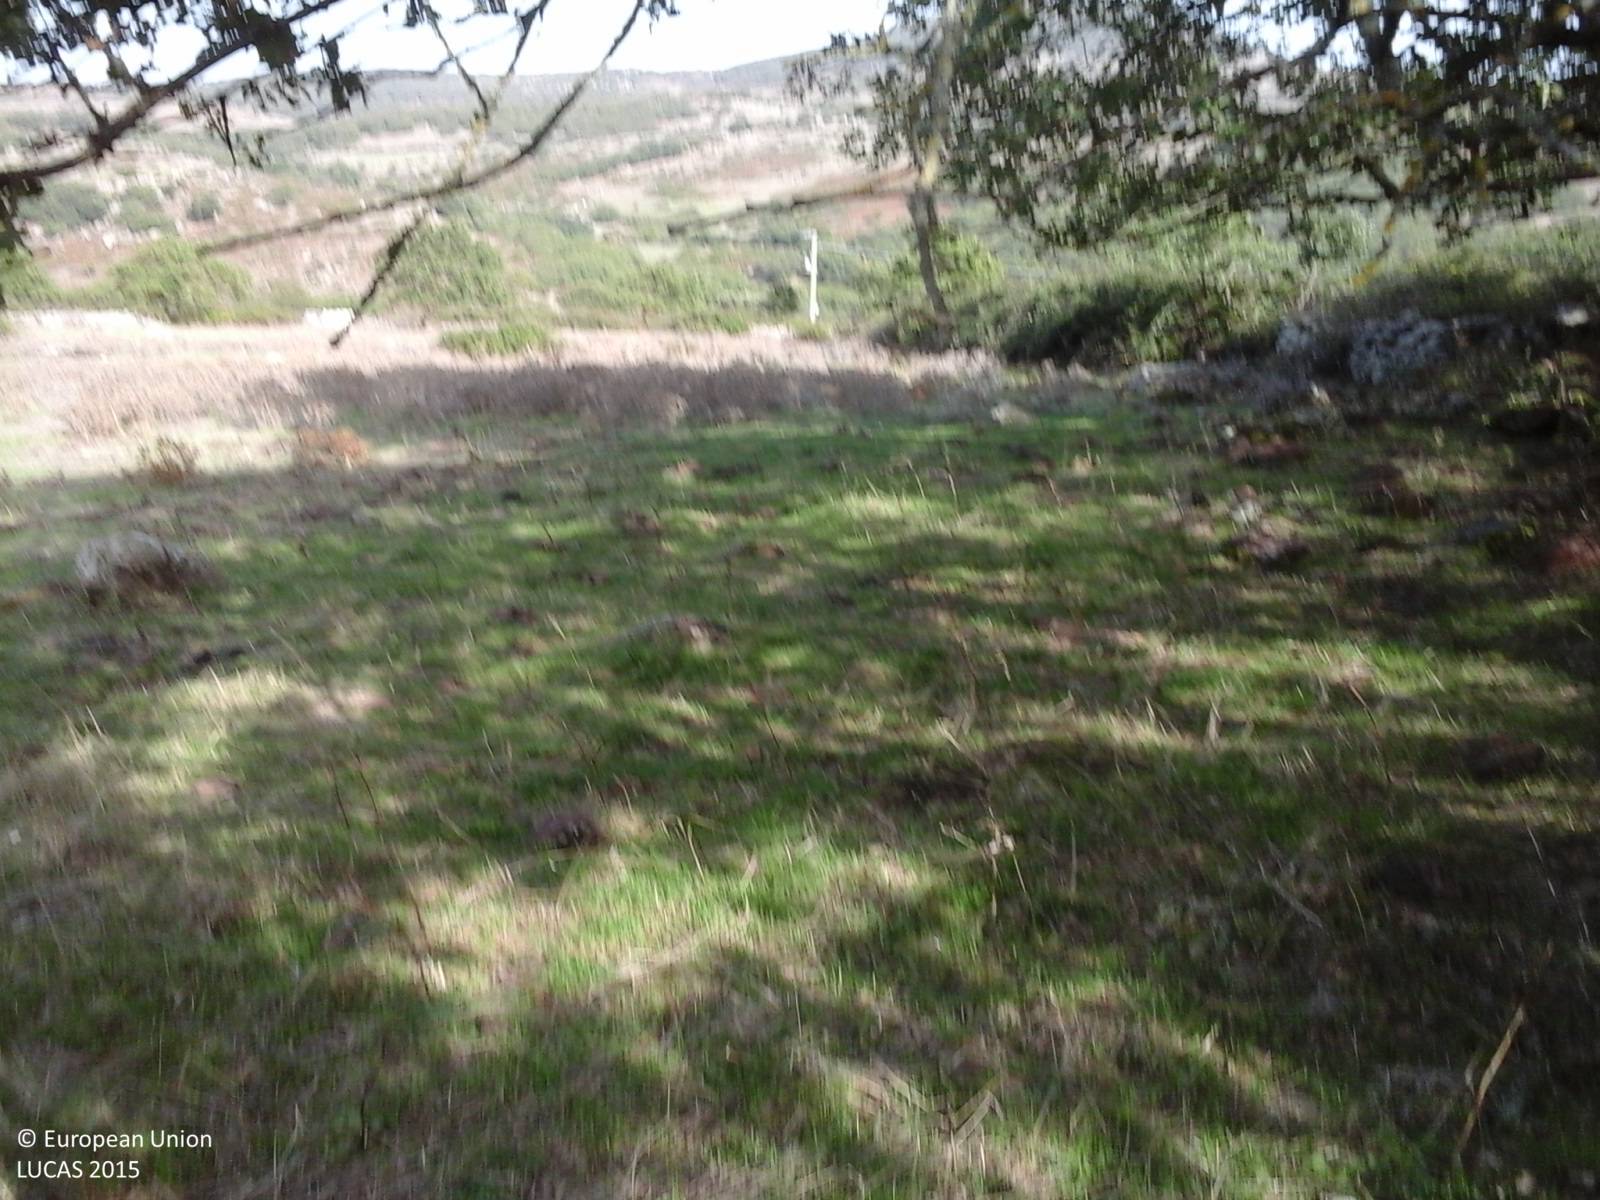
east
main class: Grassland
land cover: Grassland without tree/shrub cover
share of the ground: 25 - 50 %
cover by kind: herbaceous plants 100 %
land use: Agriculture (excluding fallow land and kitchen gardens)
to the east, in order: Grassland without tree/shrub cover; Dry stone walls; Abandoned hedges; Grassland without tree/shrub cover; Dry stone walls; Abandoned hedges; Grass margins; Paved roads, cycling and walking lanes; Grass margins; Tracks; Dry stone walls; Abandoned hedges; Grassland without tree/shrub cover; Broadleaved woodland
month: October
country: IT
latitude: 40.2964
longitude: 8.8180
